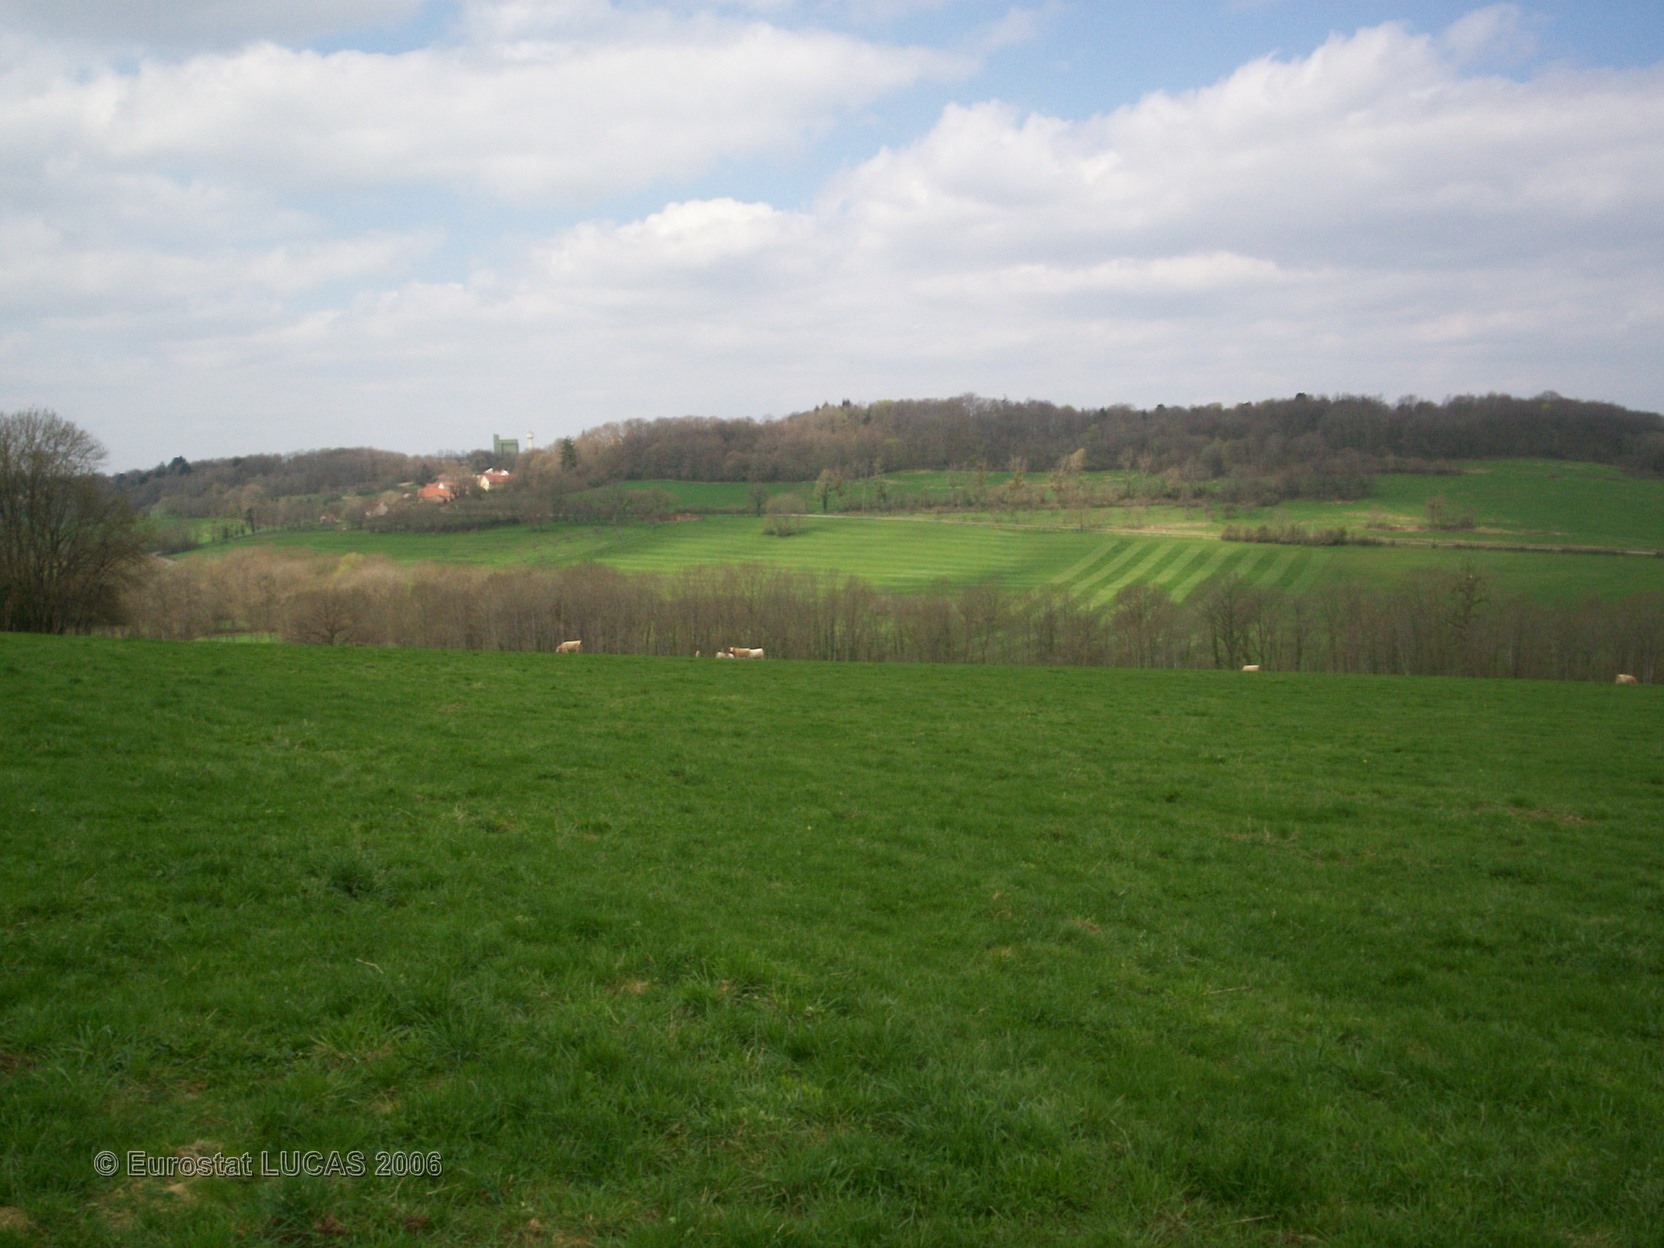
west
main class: Grassland
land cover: Grassland without tree/shrub cover
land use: Agriculture (excluding fallow land and kitchen gardens)
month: April
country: FR
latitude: 47.8881
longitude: 5.2789
